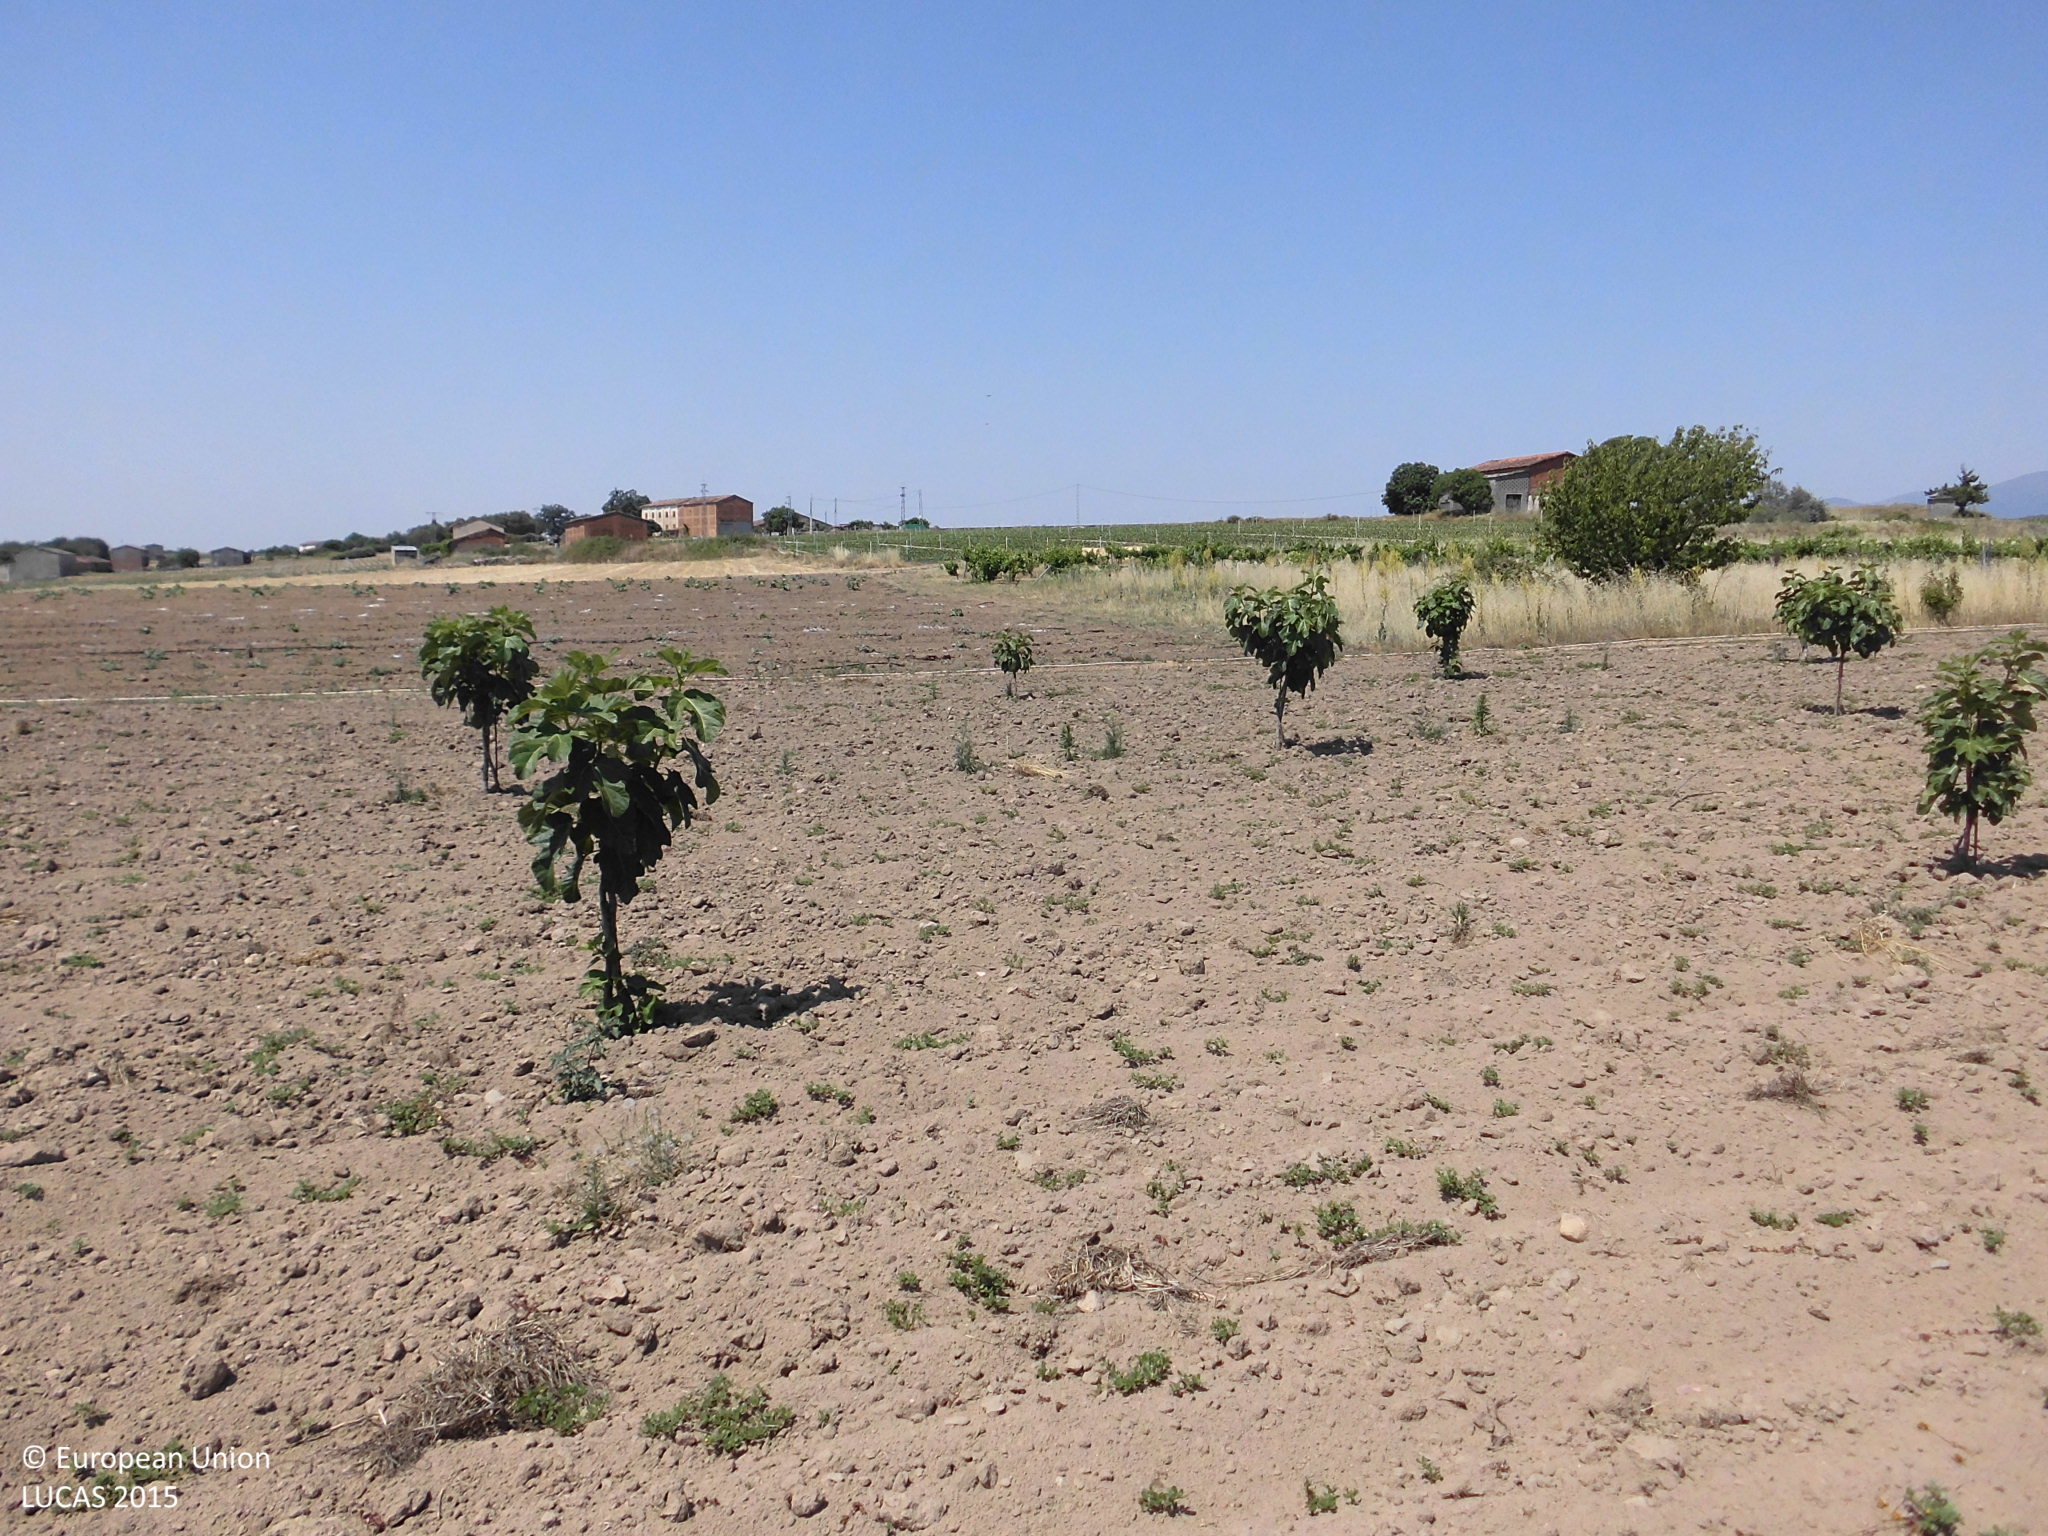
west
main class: Cropland
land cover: Other fruit trees and berries
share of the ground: < 10 %
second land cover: Other bare soil
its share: > 75 %
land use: Agriculture (excluding fallow land and kitchen gardens)
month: June
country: ES
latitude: 40.0742
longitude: -5.5041
